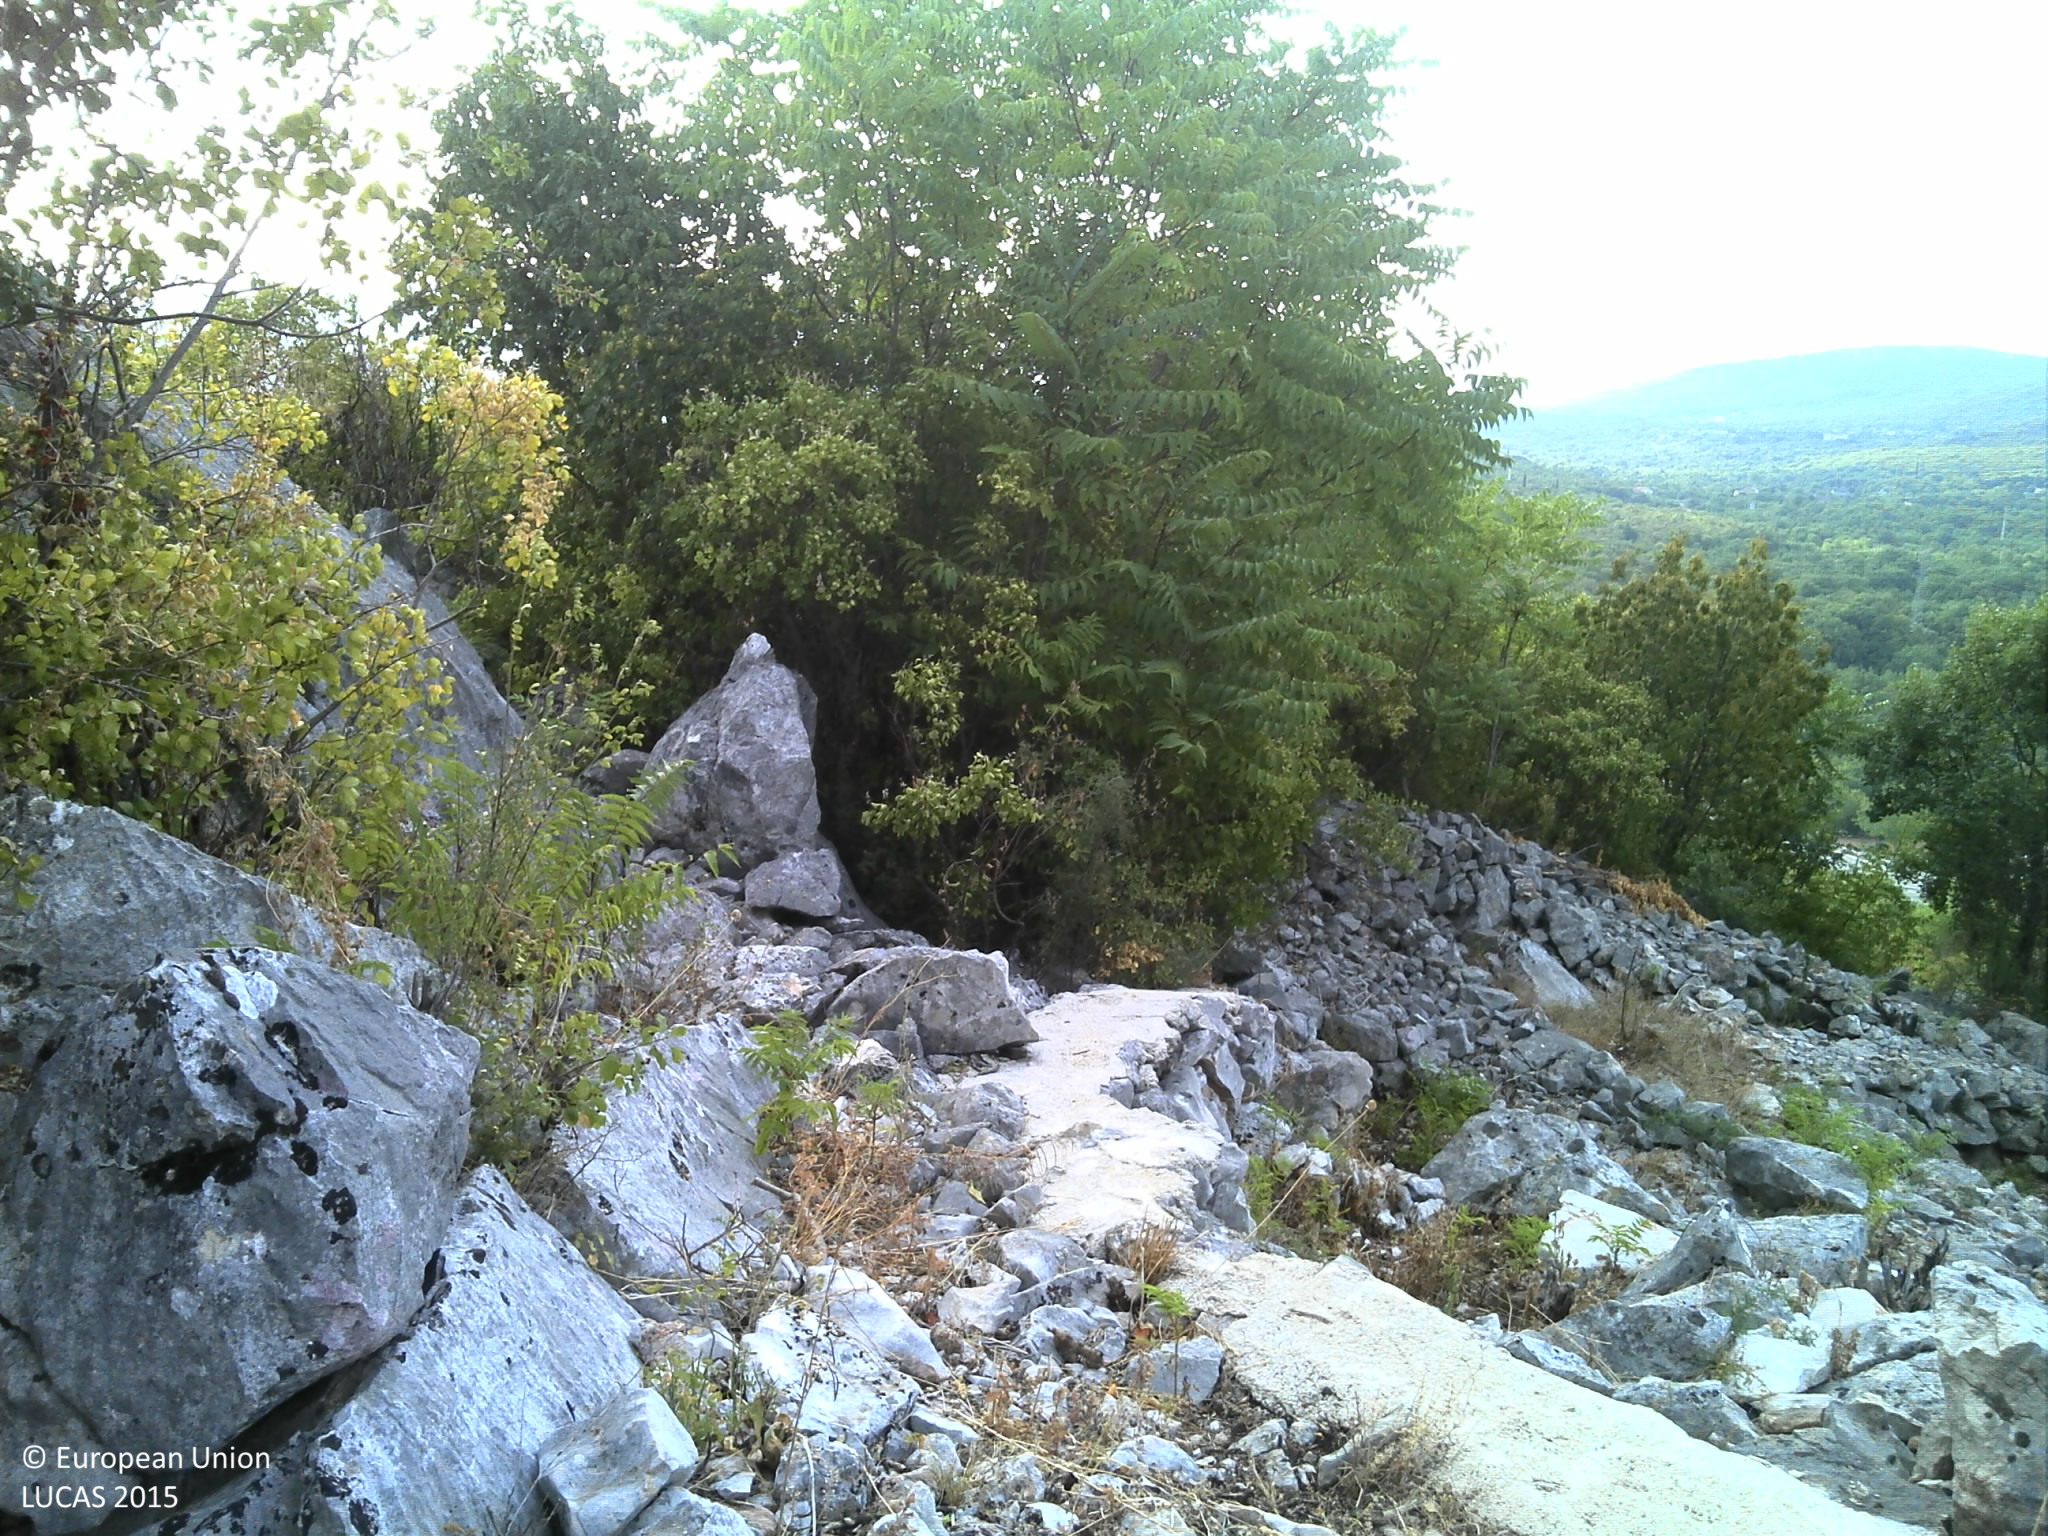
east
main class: Cropland
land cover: Other fruit trees and berries
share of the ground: 10 - 25 %
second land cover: Grassland without tree/shrub cover
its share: > 75 %
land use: Agriculture (excluding fallow land and kitchen gardens)
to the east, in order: Other fruit trees and berries; Grassland without tree/shrub cover; Dry stone walls; Broadleaved woodland; Dry stone walls; Broadleaved woodland; Pine dominated coniferous woodland; Paved roads, cycling and walking lanes; Broadleaved woodland; Paved roads, cycling and walking lanes; Broadleaved woodland
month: July
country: HR
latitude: 43.4359
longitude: 17.1202
